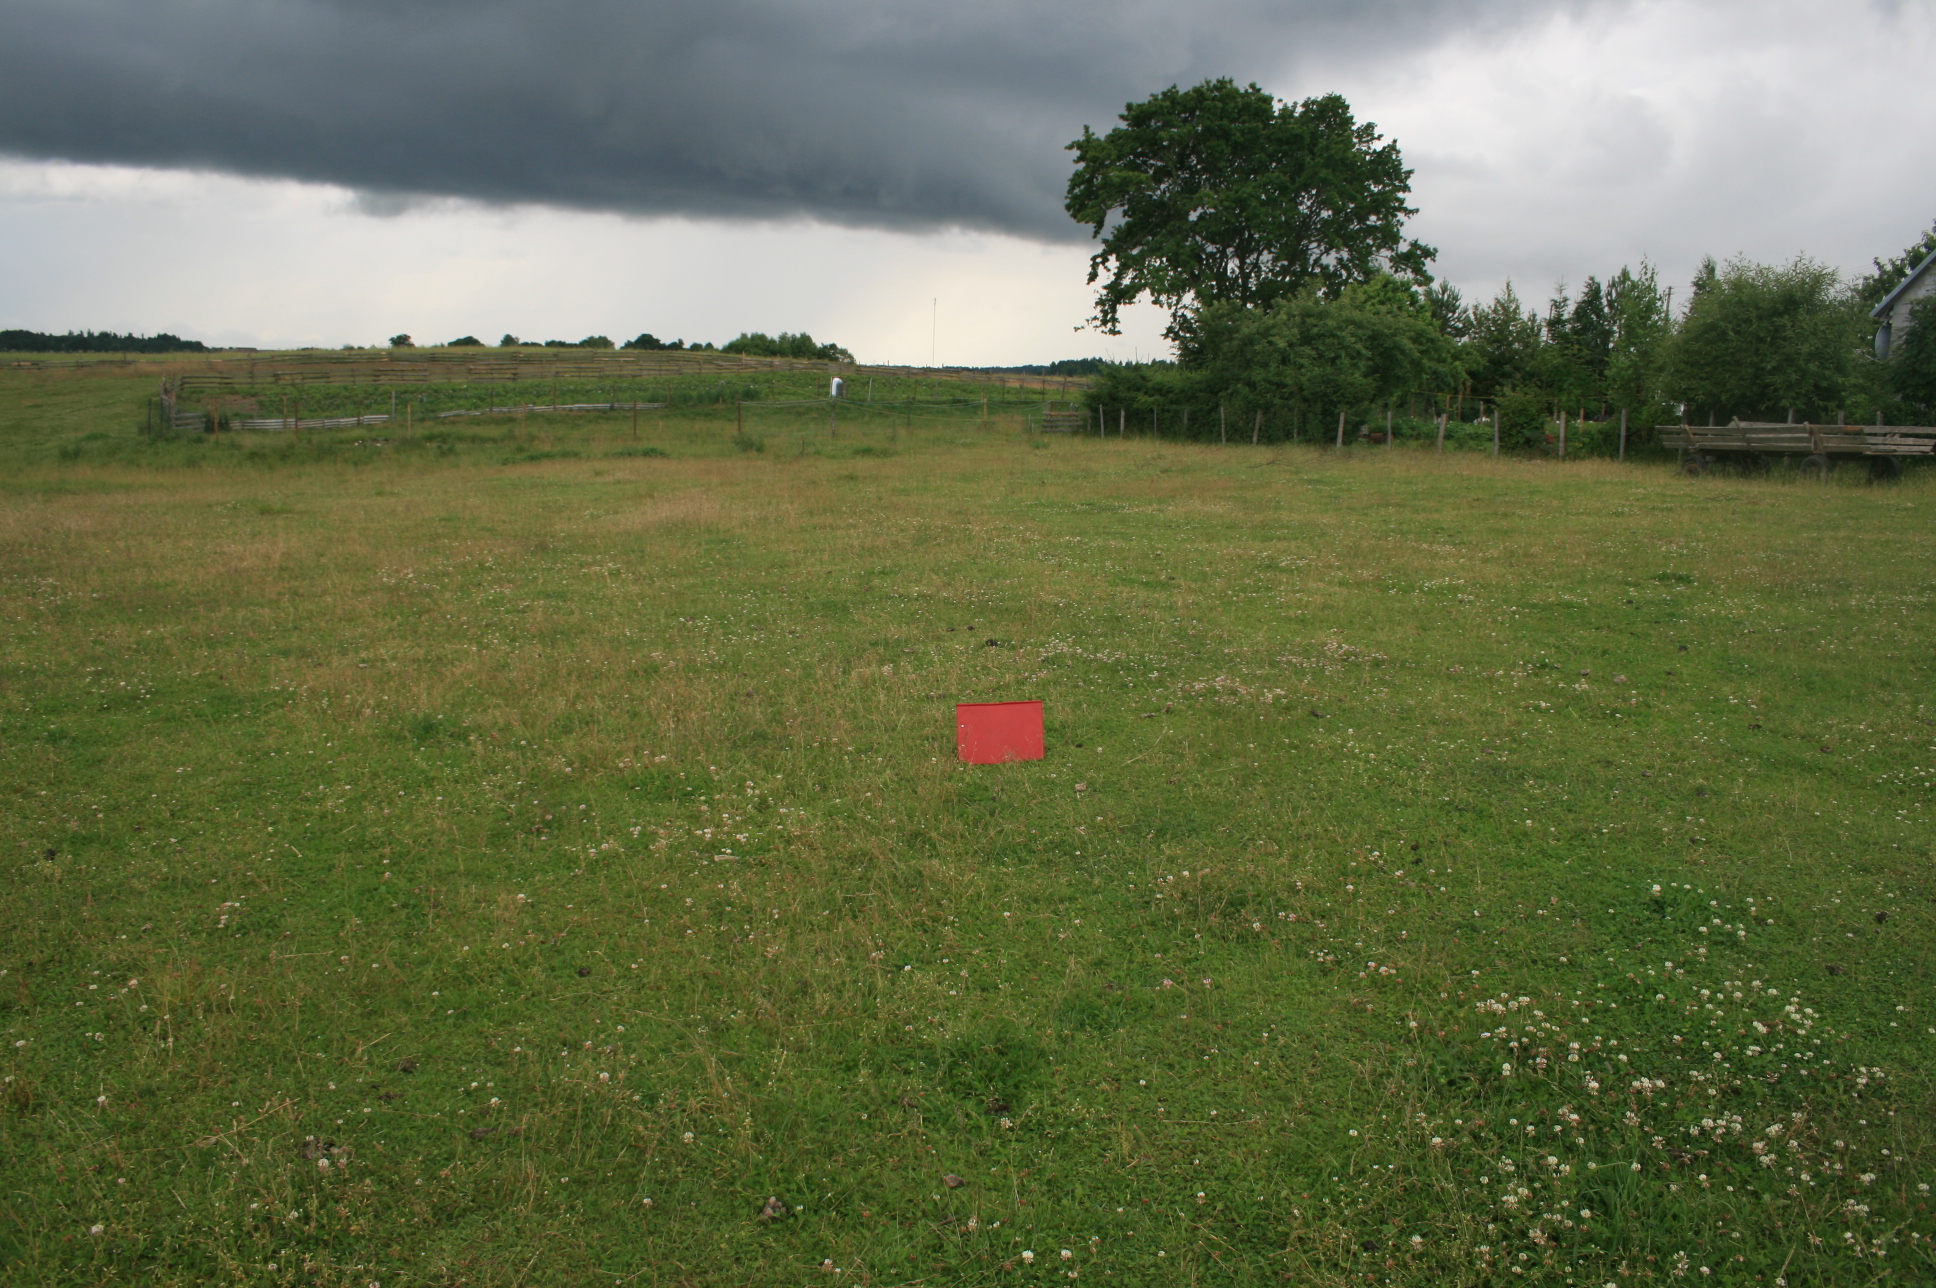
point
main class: Grassland
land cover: Grassland without tree/shrub cover
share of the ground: > 75 %
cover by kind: herbaceous plants 100 %
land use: Agriculture (excluding fallow land and kitchen gardens)
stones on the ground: < 10 %
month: July
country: LT
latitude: 56.0929
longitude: 22.0261
